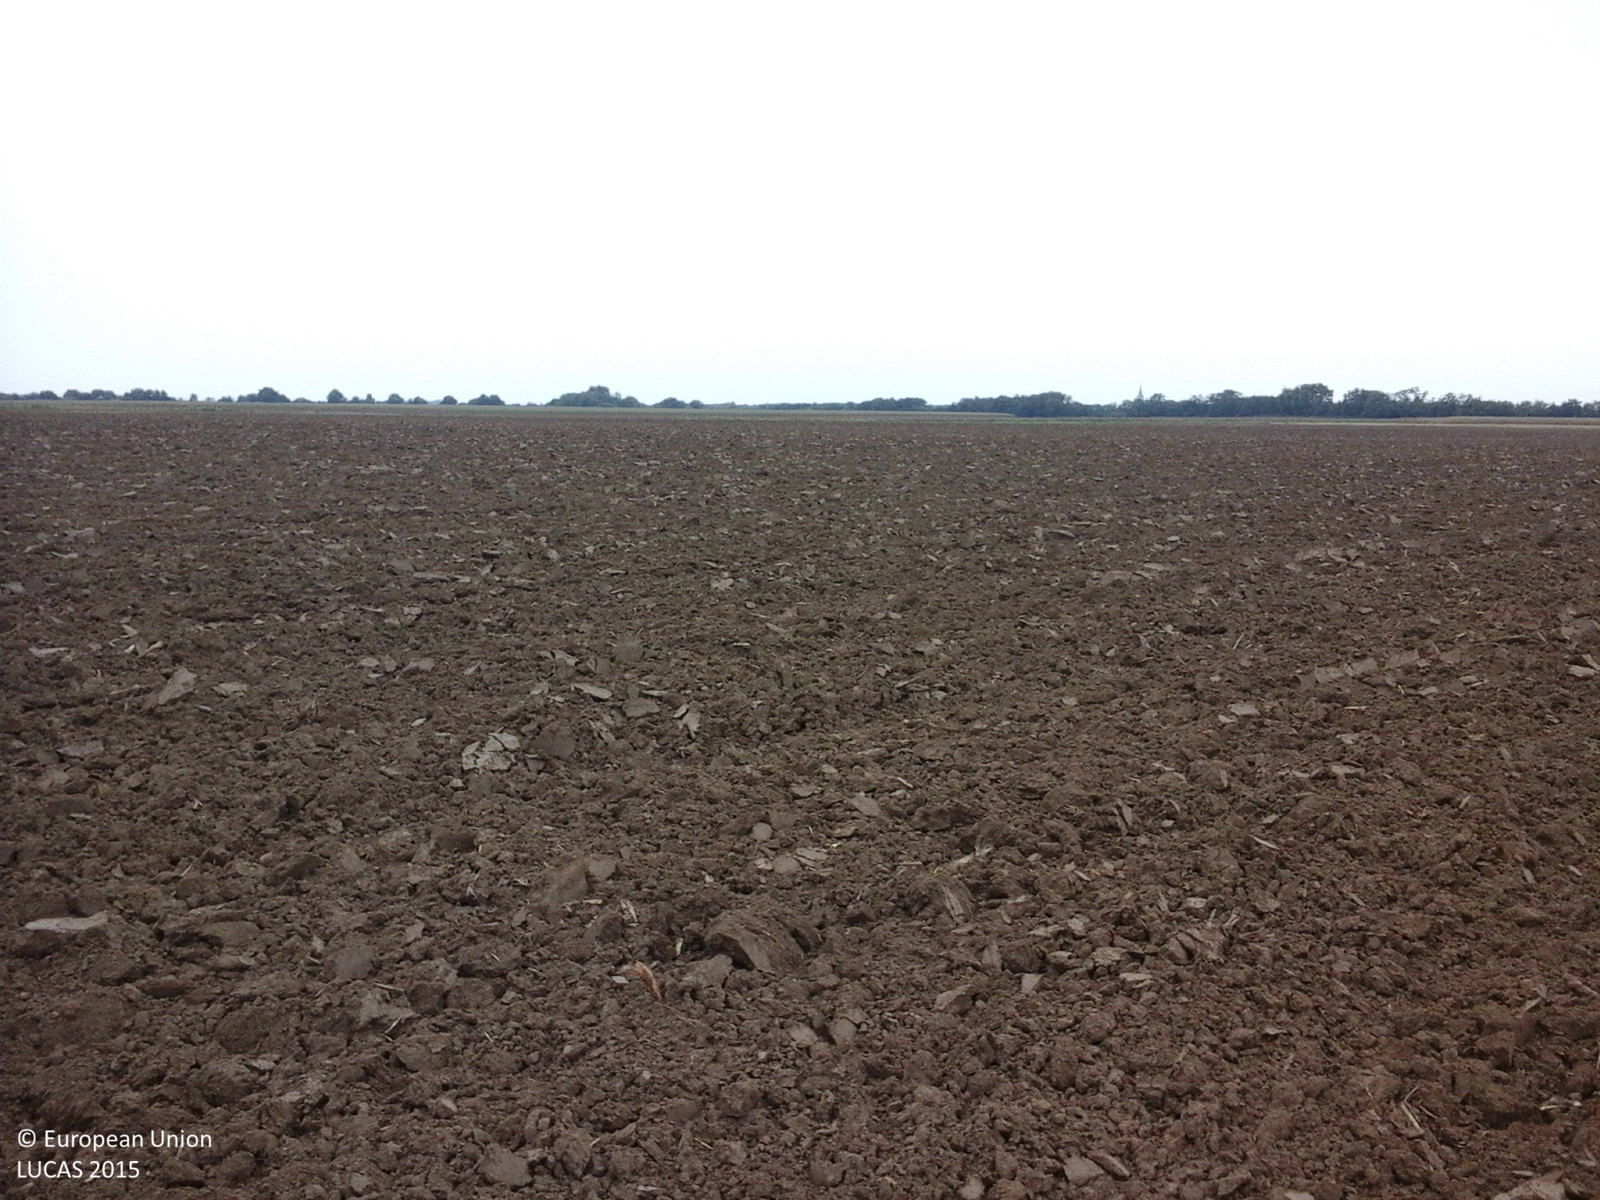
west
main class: Cropland
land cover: Common wheat
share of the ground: < 10 %
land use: Agriculture (excluding fallow land and kitchen gardens)
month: September
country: RO
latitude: 47.4680
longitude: 22.0570
